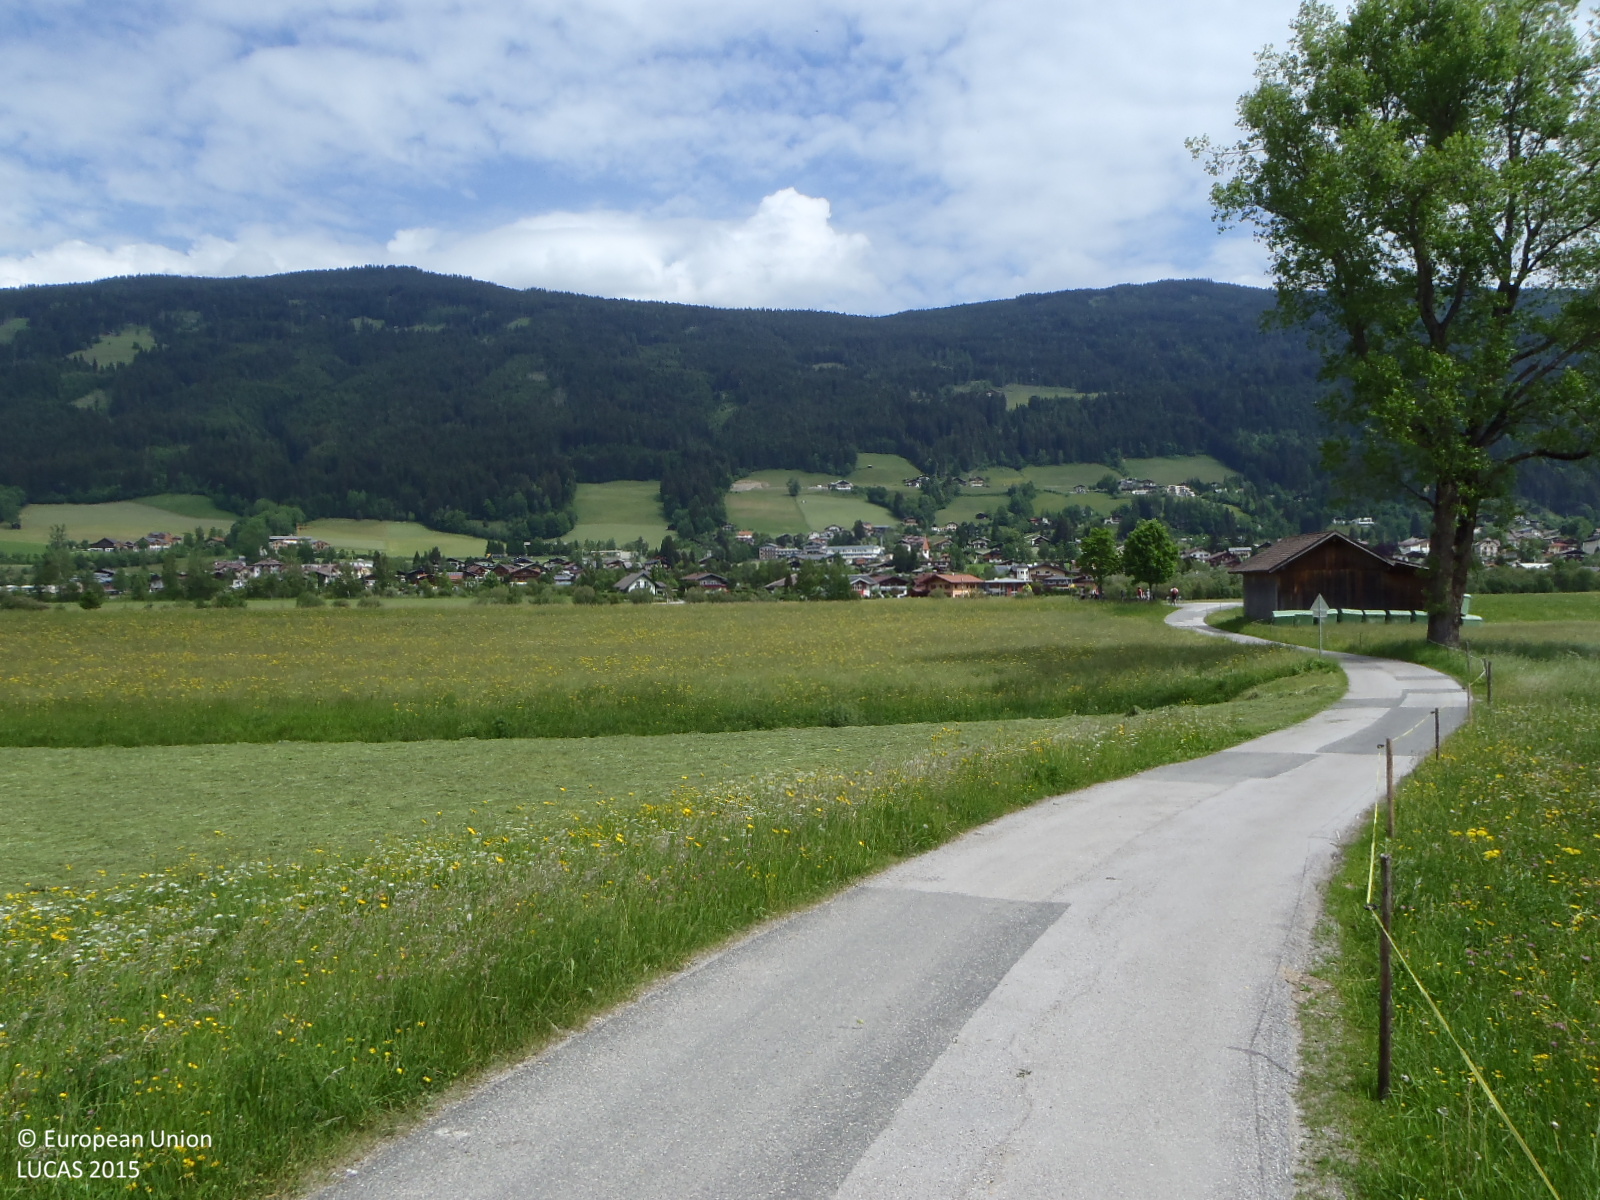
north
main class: Grassland
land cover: Grassland without tree/shrub cover
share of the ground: > 75 %
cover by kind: herbaceous plants 100 %
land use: Agriculture (excluding fallow land and kitchen gardens)
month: June
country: AT
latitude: 47.3768
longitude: 13.4550
